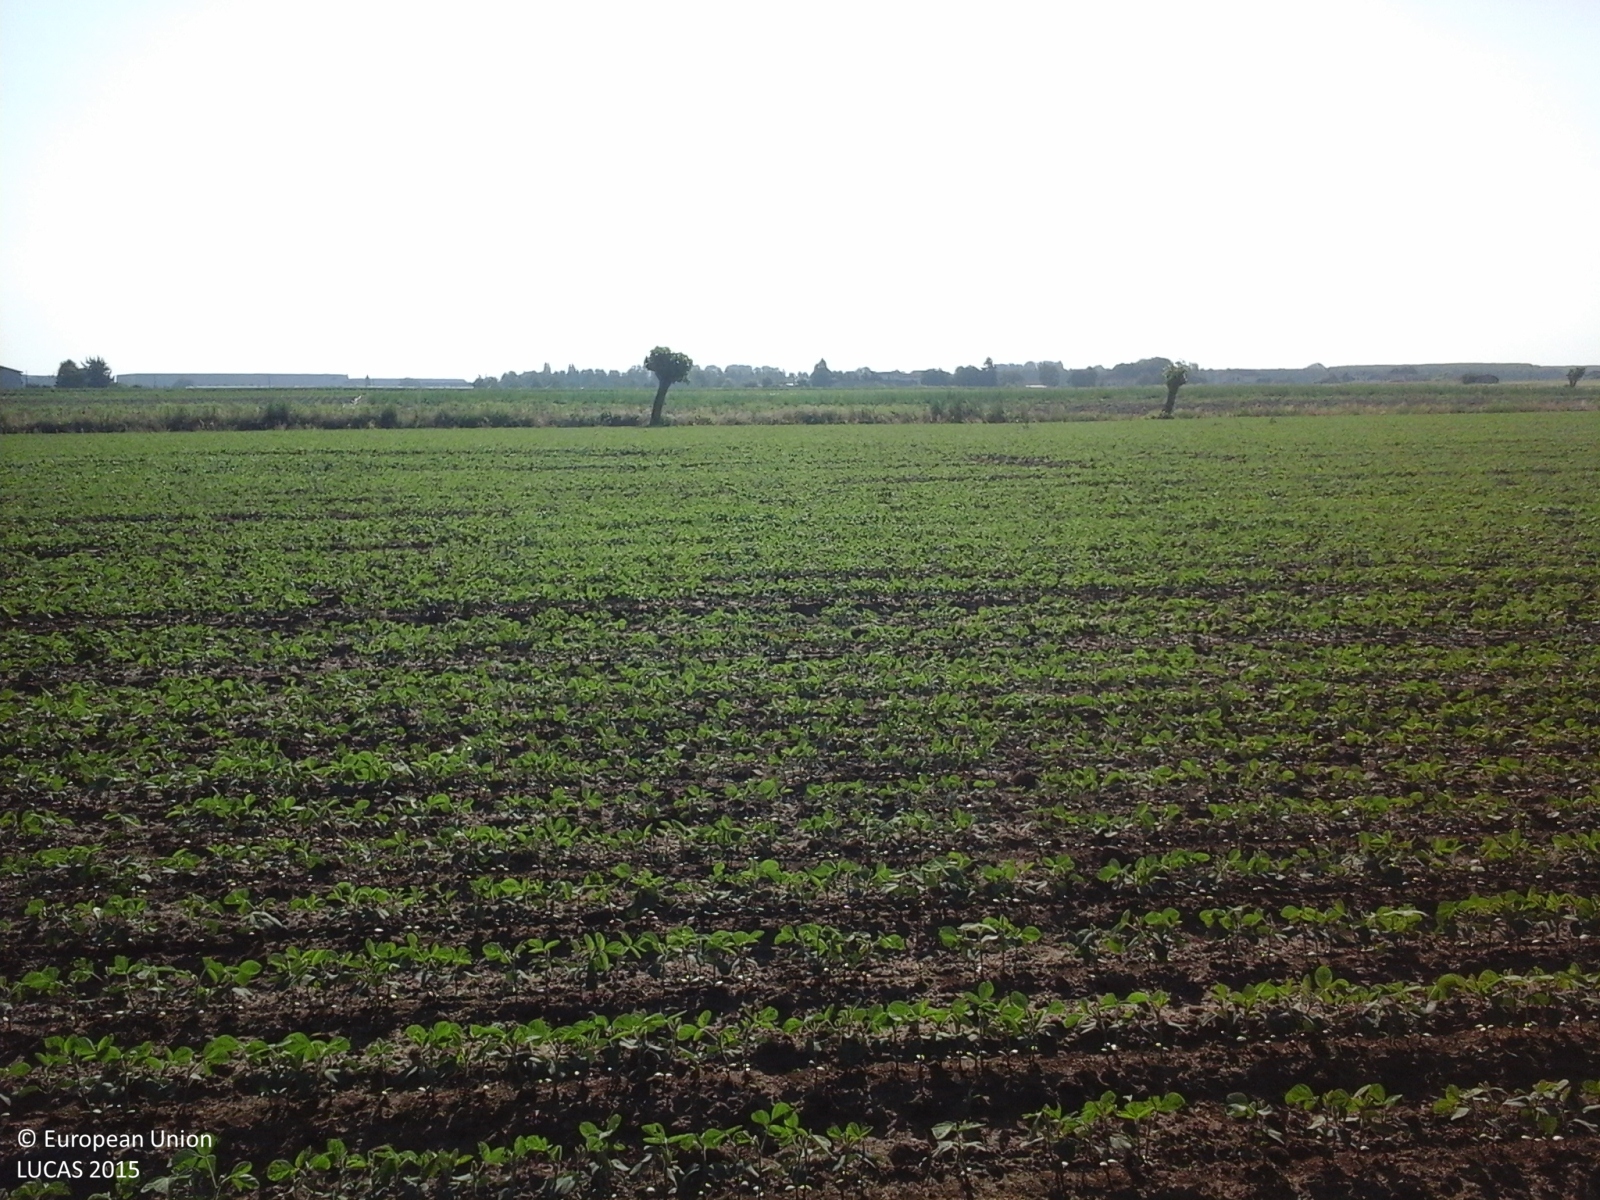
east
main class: Cropland
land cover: Common wheat
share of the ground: > 75 %
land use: Agriculture (excluding fallow land and kitchen gardens)
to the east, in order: Common wheat; Ditches and canals; Soya; Ditches and canals; Grass margins; Other bare soil; Spontaneously vegetated surfaces
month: May
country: IT
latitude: 45.1930
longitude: 11.0291
